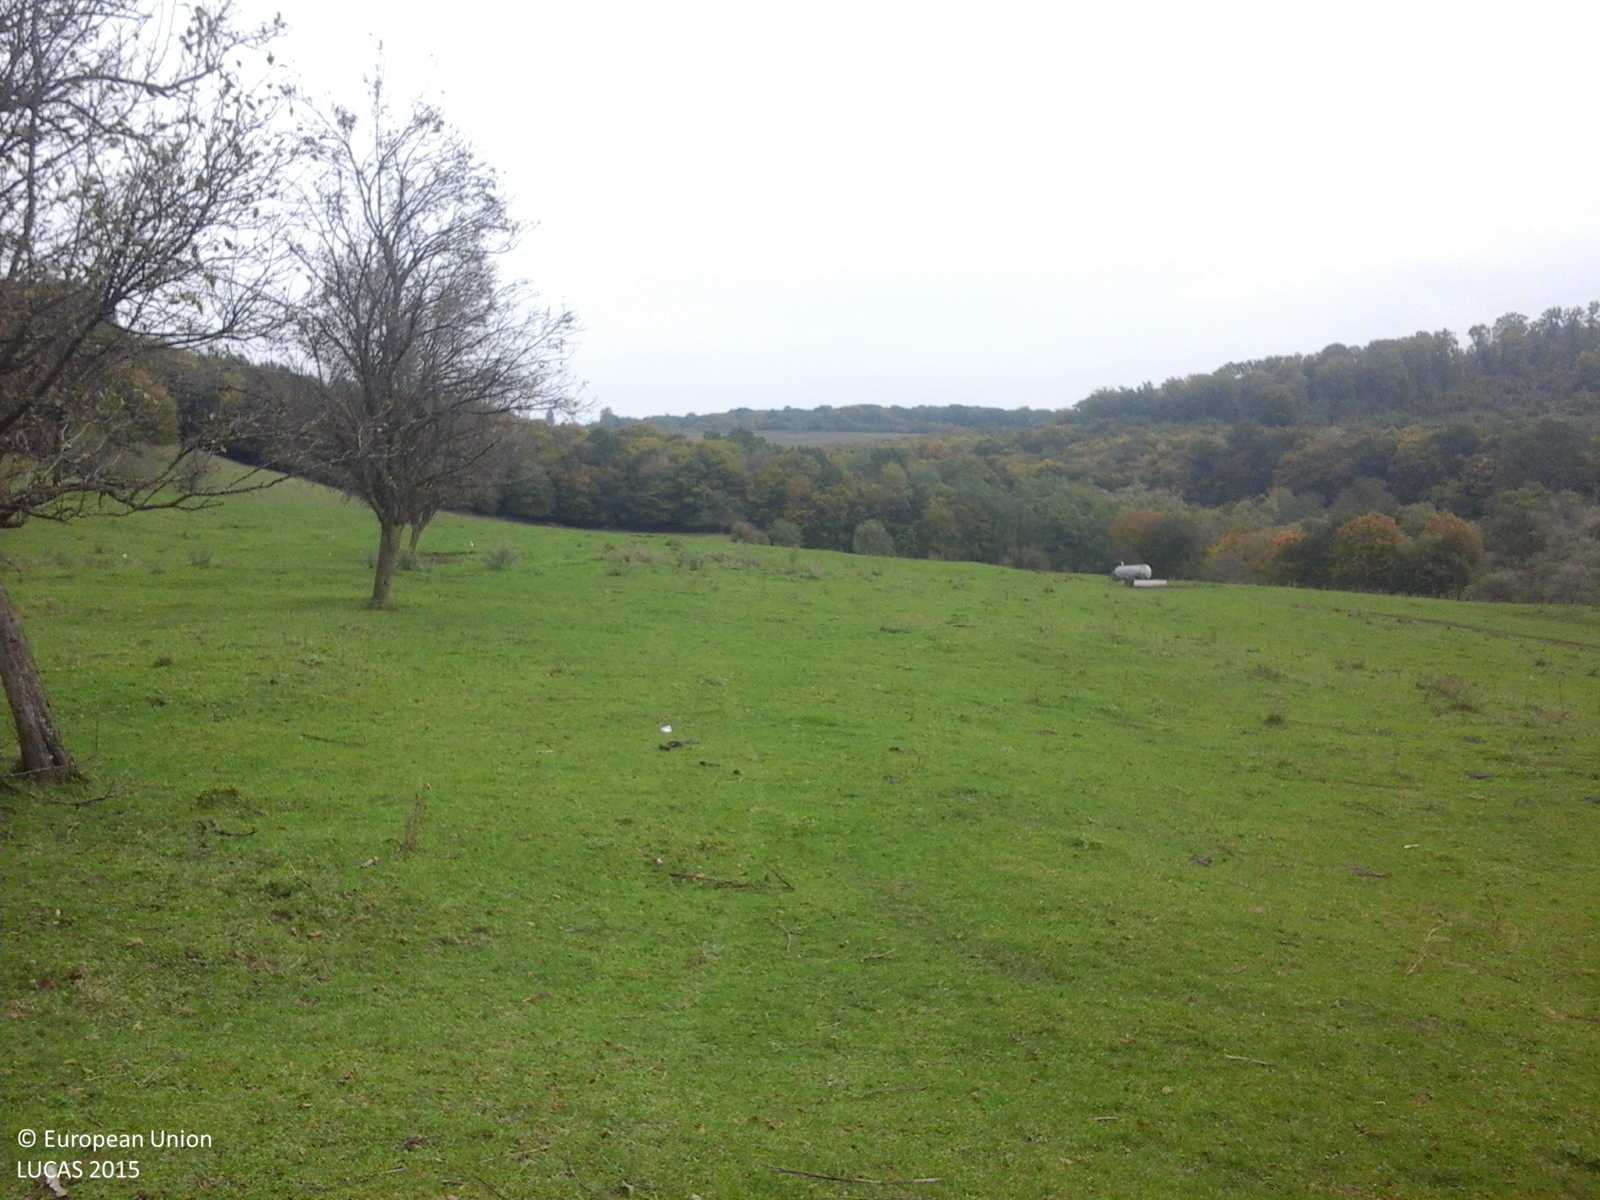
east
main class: Grassland
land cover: Grassland without tree/shrub cover
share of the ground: > 75 %
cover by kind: herbaceous plants 100 %
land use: Agriculture (excluding fallow land and kitchen gardens)
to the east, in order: Grassland without tree/shrub cover; Abandoned hedges; Grassland without tree/shrub cover; Broadleaved woodland
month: October
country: RO
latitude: 45.8868
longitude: 24.7652
